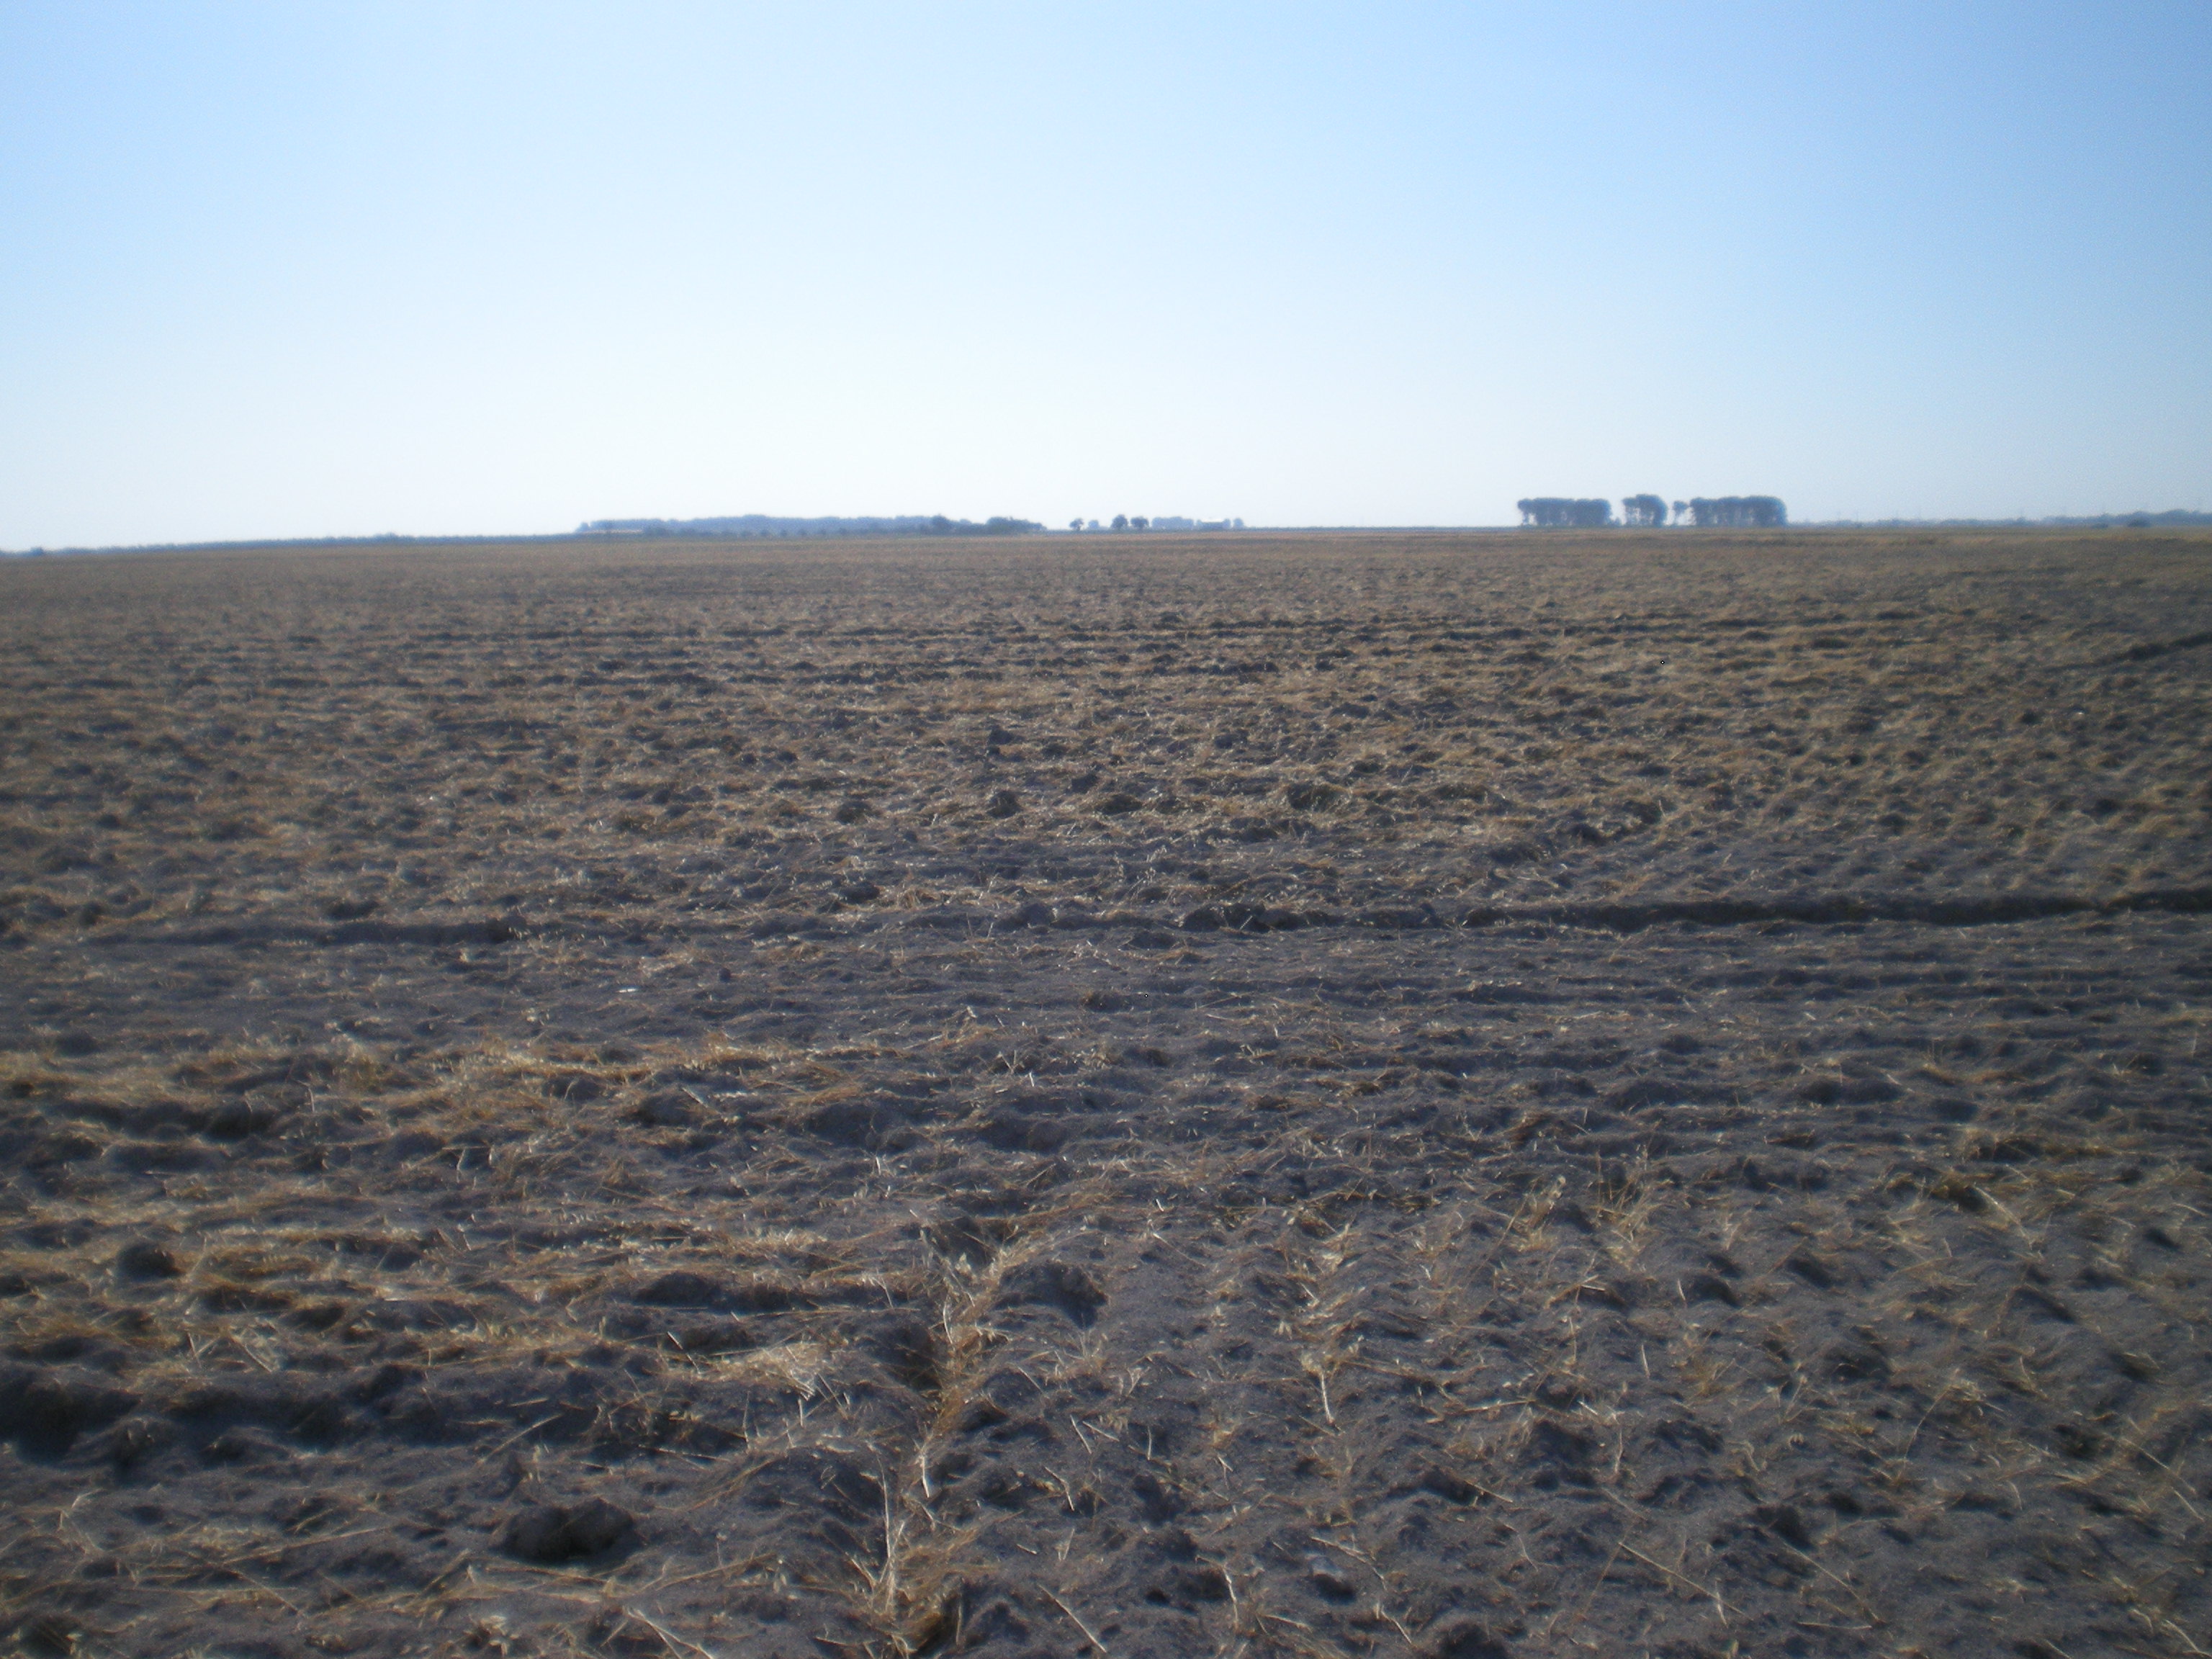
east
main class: Cropland
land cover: Common wheat
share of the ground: < 10 %
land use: Agriculture (excluding fallow land and kitchen gardens)
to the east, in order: Common wheat; Other bare soil
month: July
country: ES
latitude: 39.2968
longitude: -3.3410
